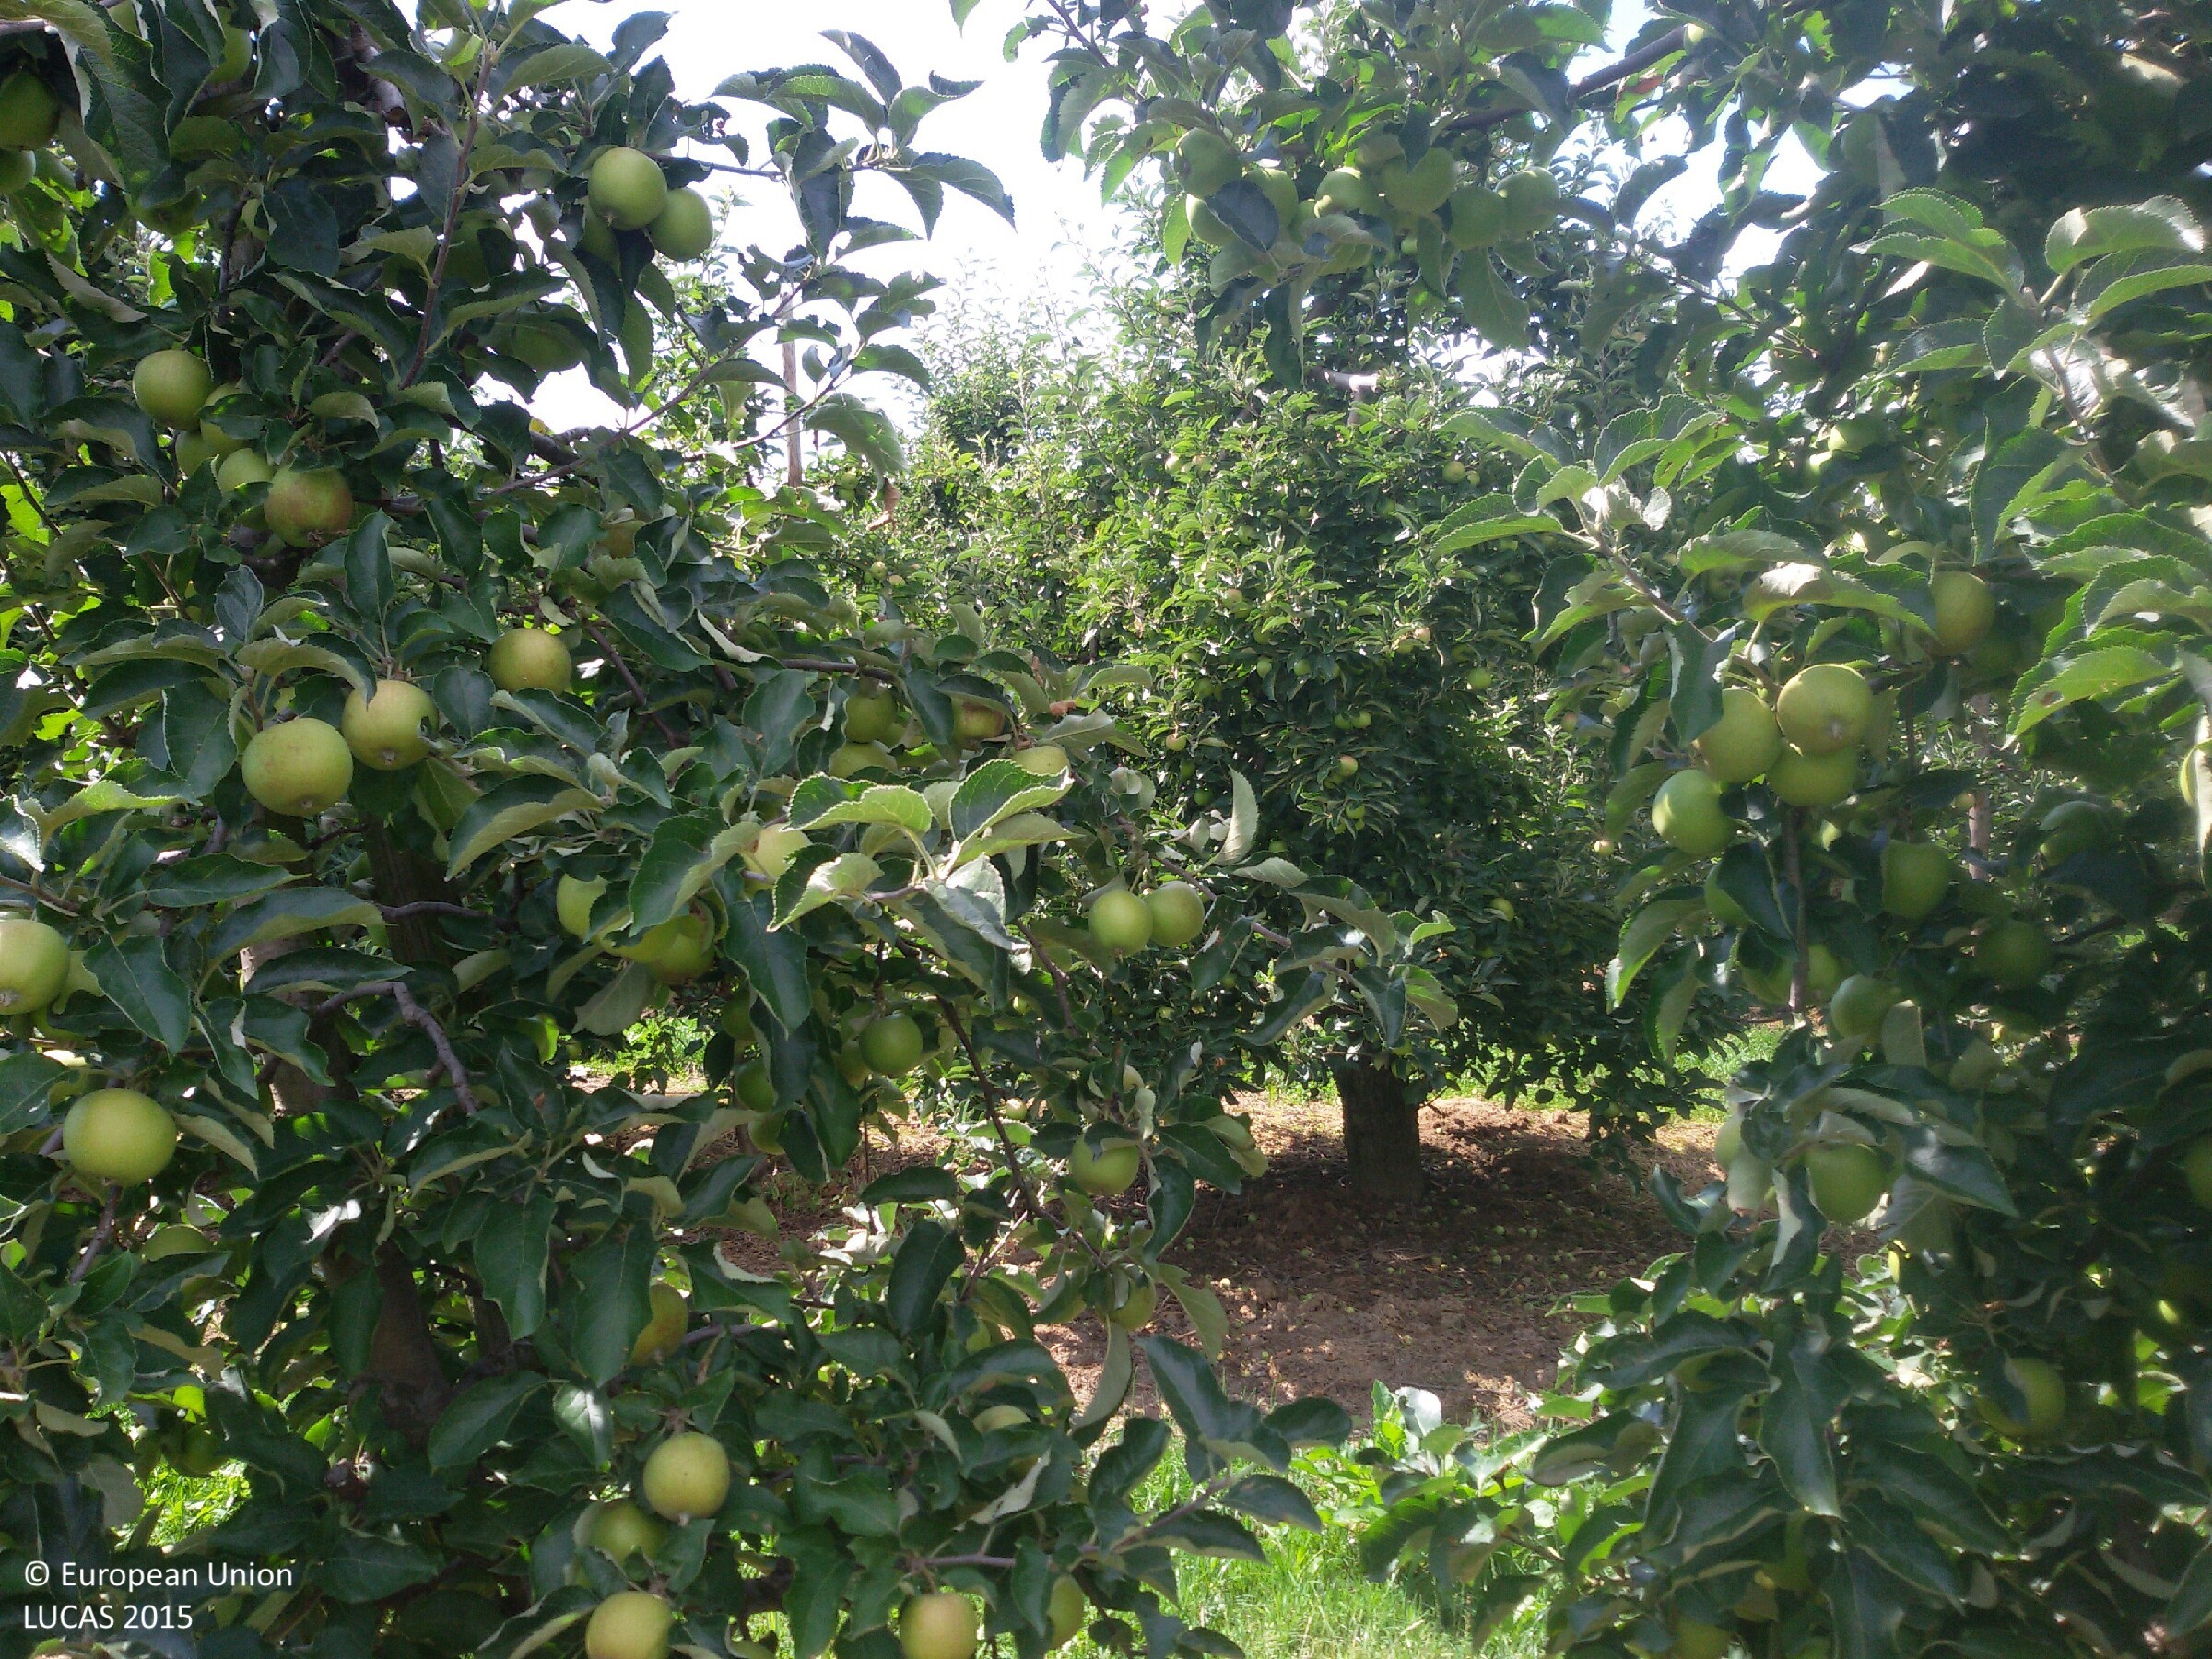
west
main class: Cropland
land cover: Apple fruit
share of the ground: > 75 %
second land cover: Grassland without tree/shrub cover
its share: > 75 %
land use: Agriculture (excluding fallow land and kitchen gardens)
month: July
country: PL
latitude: 50.6374
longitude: 21.6616
